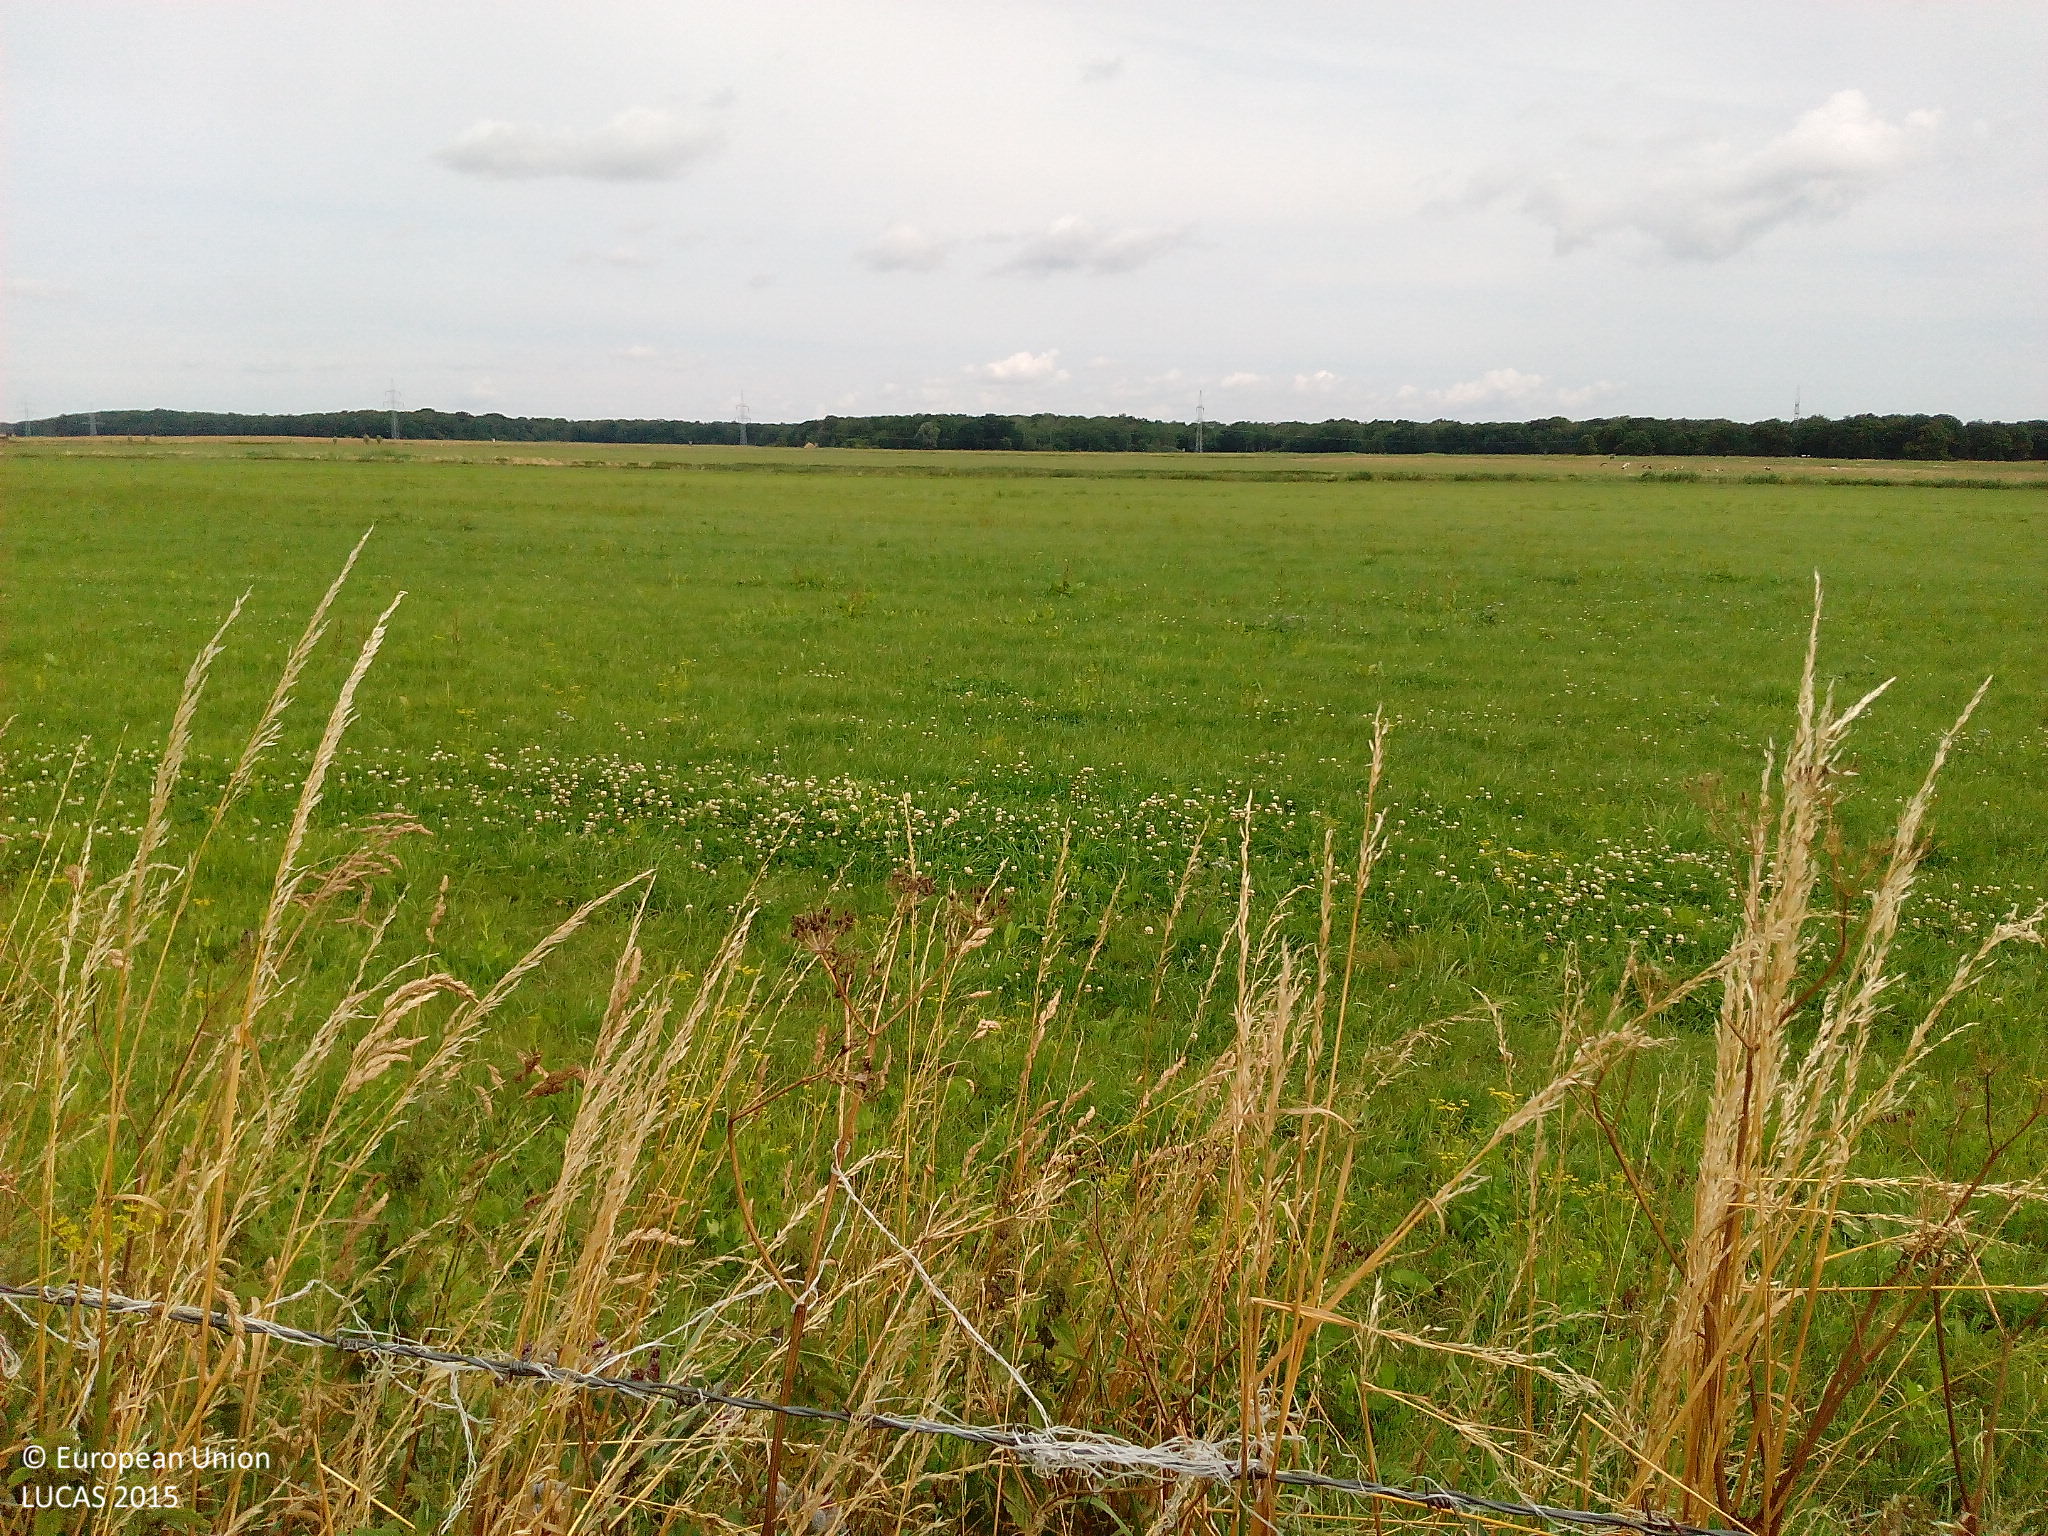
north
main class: Grassland
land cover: Grassland without tree/shrub cover
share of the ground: > 75 %
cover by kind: herbaceous plants 100 %
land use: Agriculture (excluding fallow land and kitchen gardens)
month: July
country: DE
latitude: 54.0949
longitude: 13.2868
